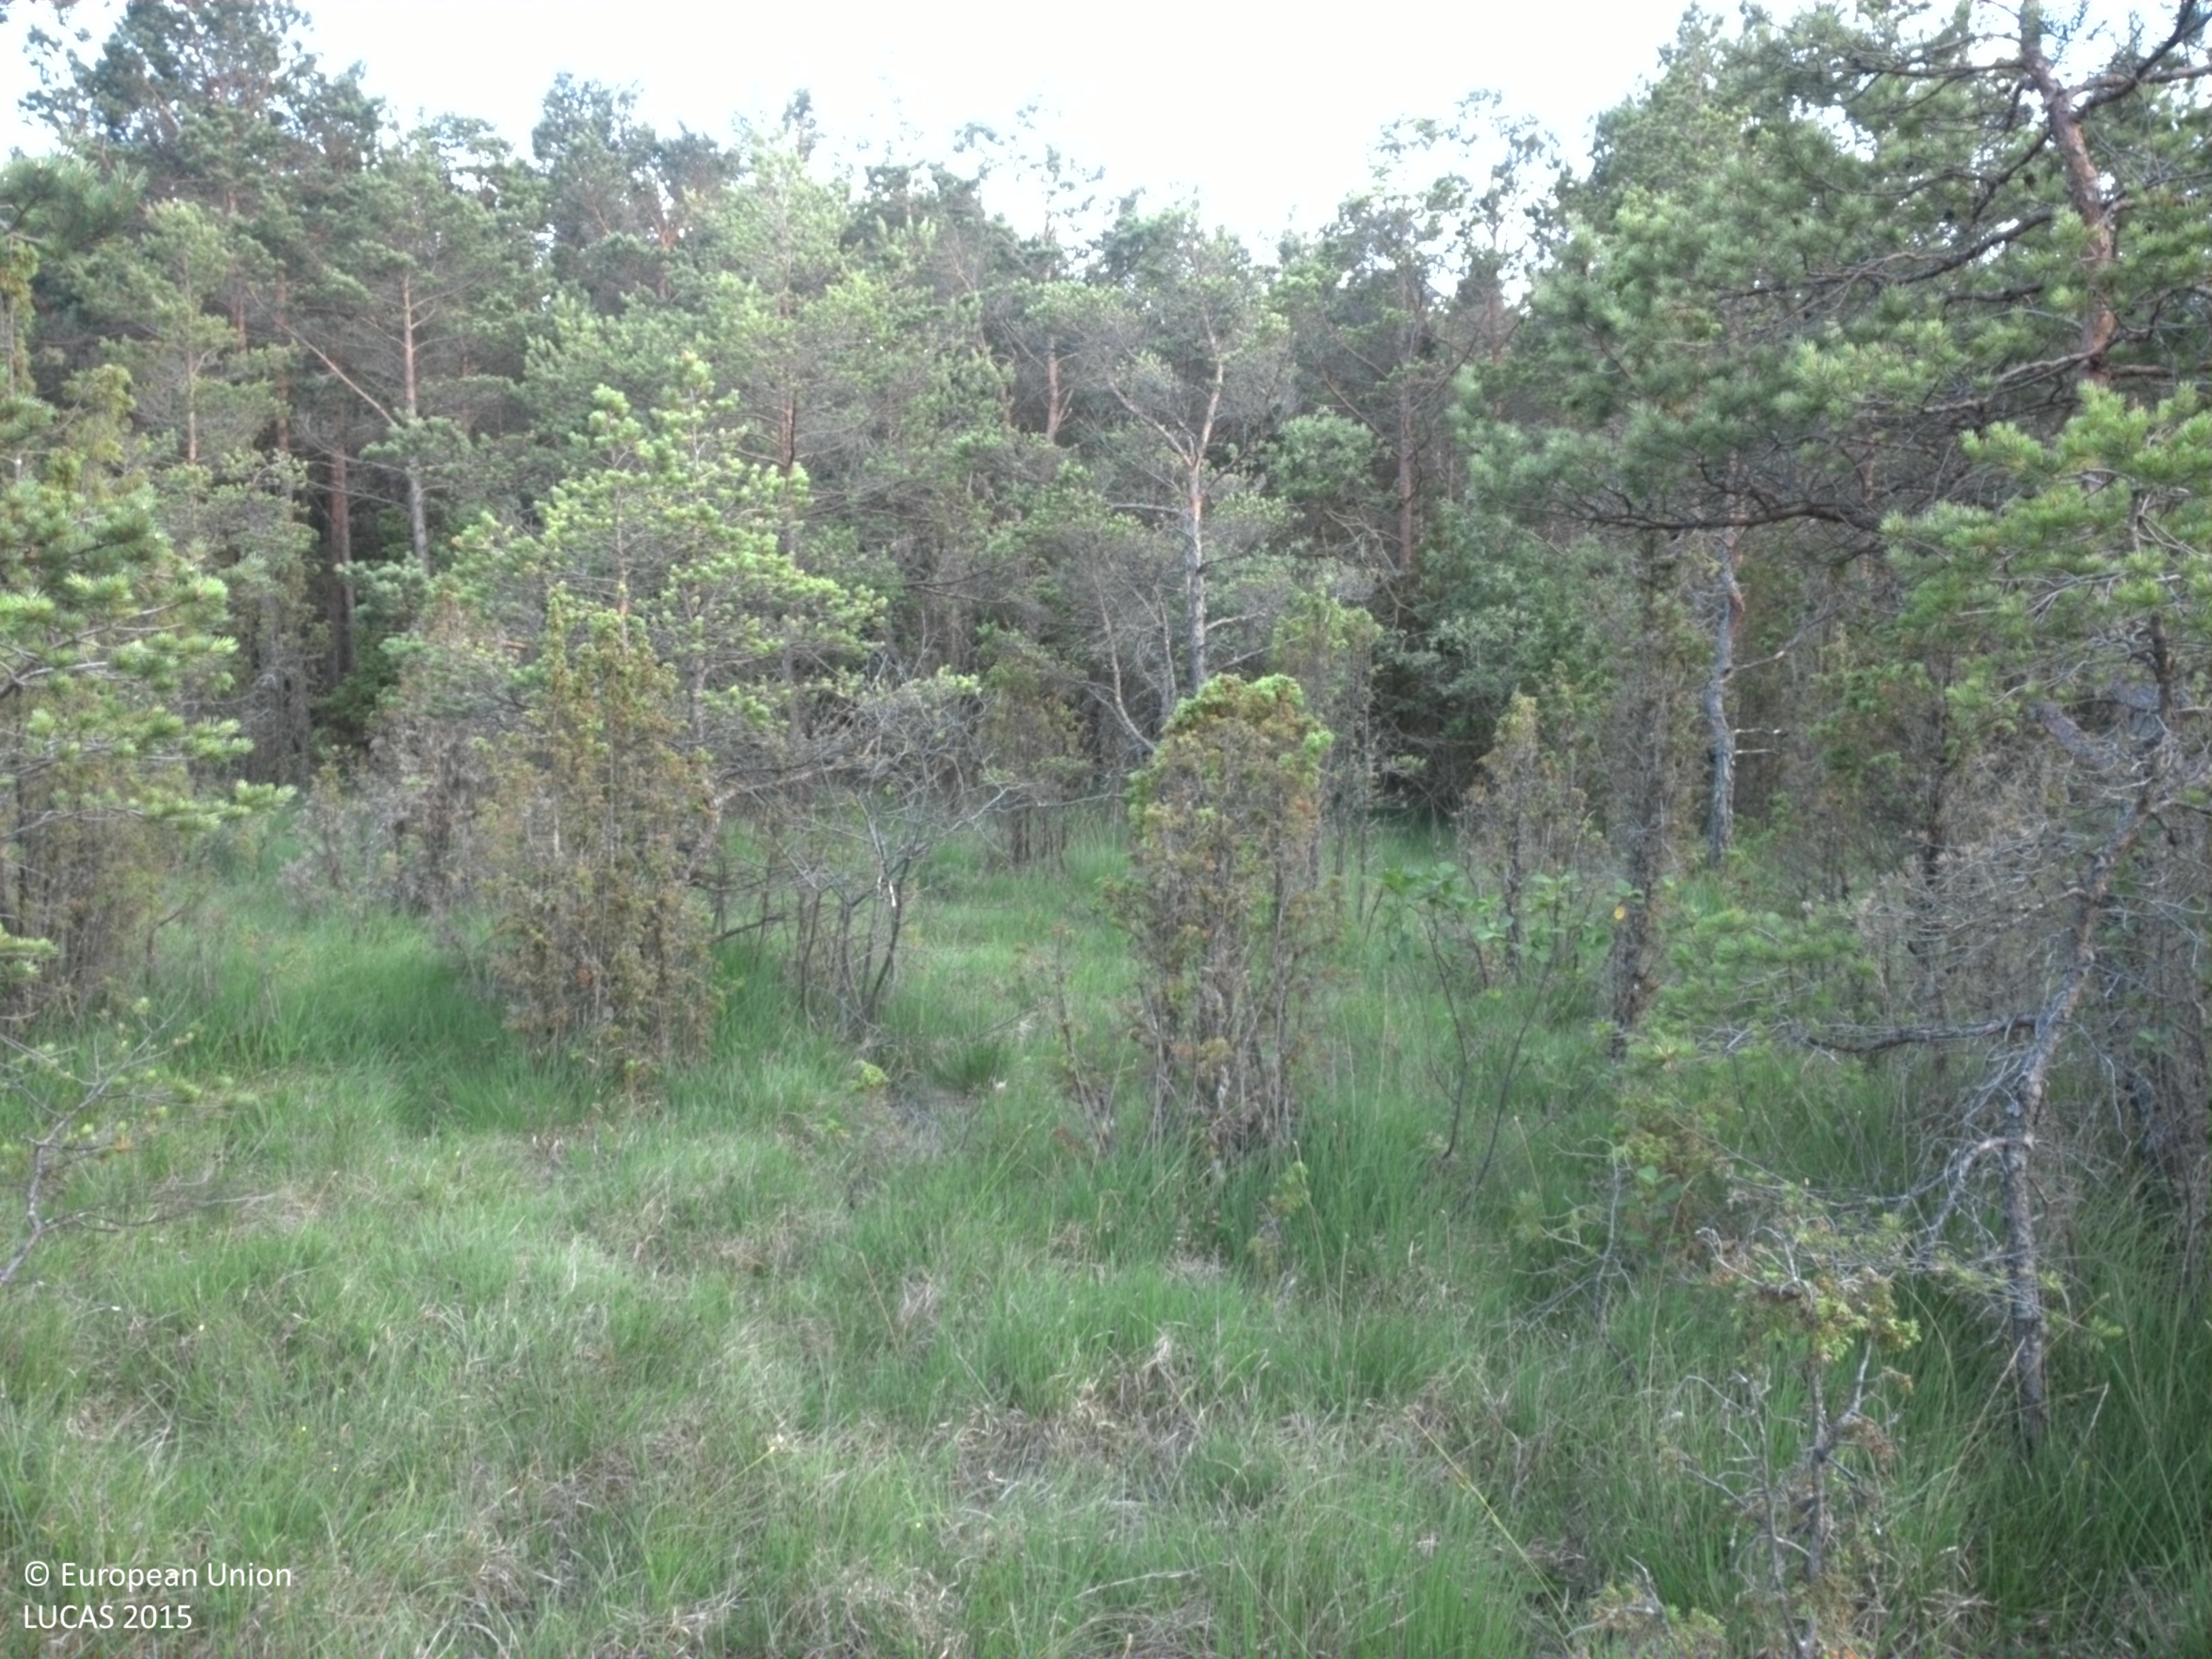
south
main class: Shrubland
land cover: Shrubland with sparse tree cover
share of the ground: > 75 %
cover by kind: shrubs 50 %, herbaceous plants 45 %, coniferous forest trees 5 %
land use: Semi-natural and natural areas not in use
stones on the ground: < 10 %
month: July
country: SE
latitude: 57.5736
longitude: 18.7215
